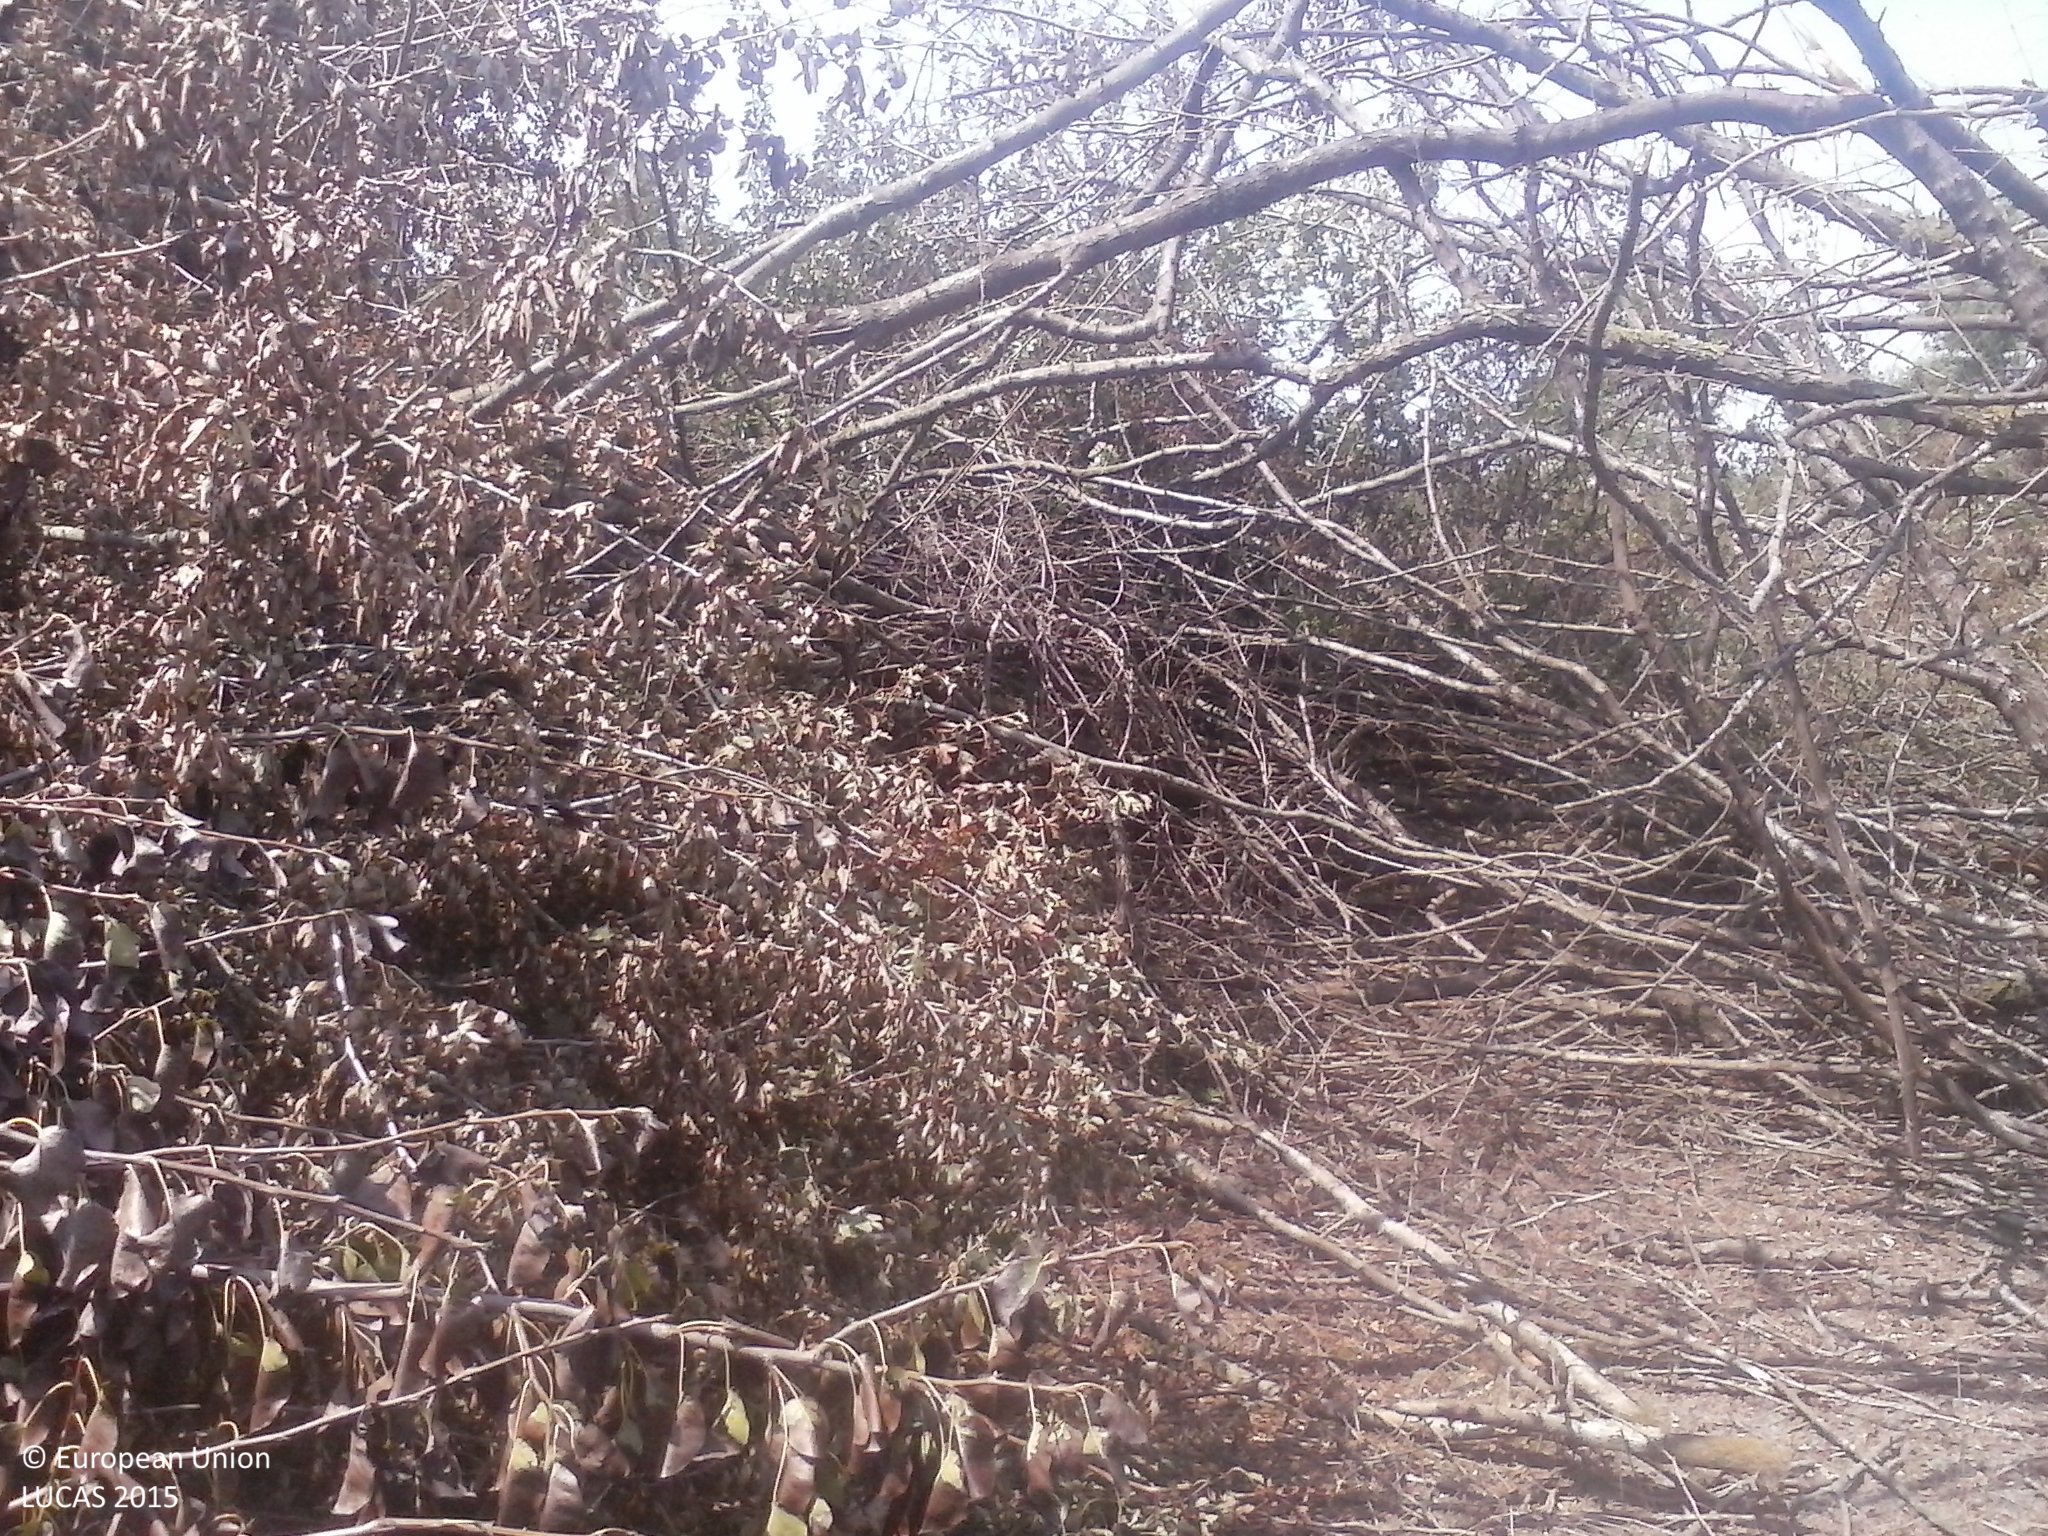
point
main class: Woodland
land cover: Broadleaved woodland
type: mesophytic deciduous forest
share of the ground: > 75 %
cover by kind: broadleaved forest trees 90 %, shrubs 5 %, herbaceous plants 5 %
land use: Forestry
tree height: < 5 m
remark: Clear cut
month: August
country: HU
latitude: 45.9210
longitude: 17.8053
